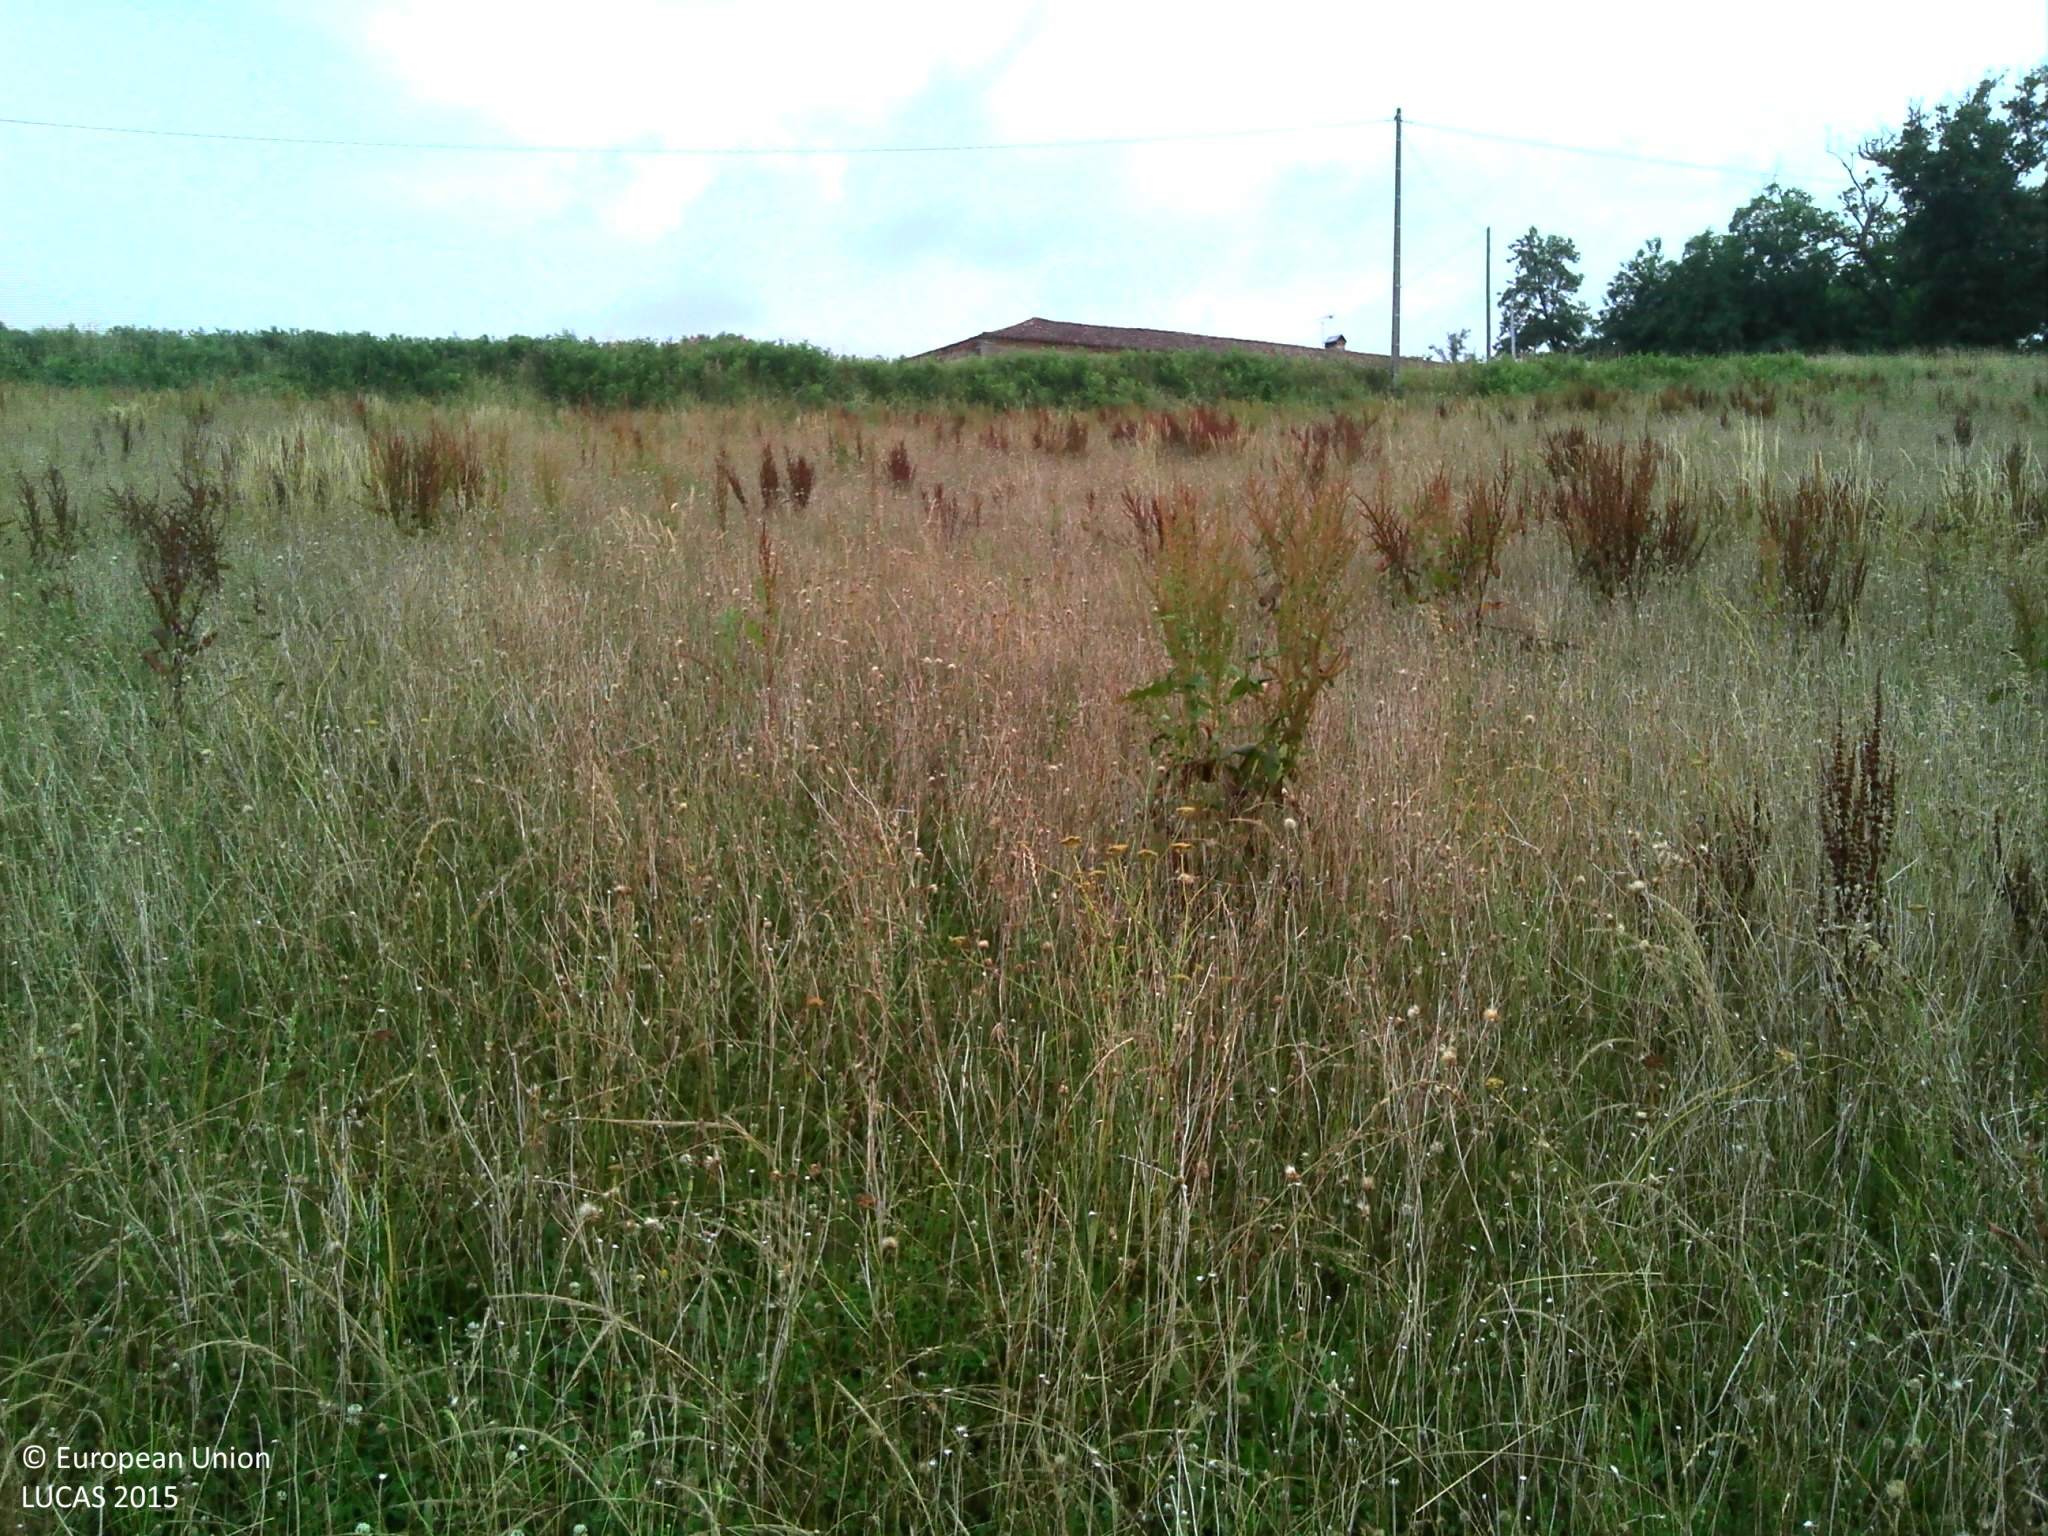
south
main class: Grassland
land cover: Grassland without tree/shrub cover
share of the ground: > 75 %
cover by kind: herbaceous plants 100 %
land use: Agriculture (excluding fallow land and kitchen gardens)
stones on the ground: < 10 %
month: July
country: FR
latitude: 43.6796
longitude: -0.7673
